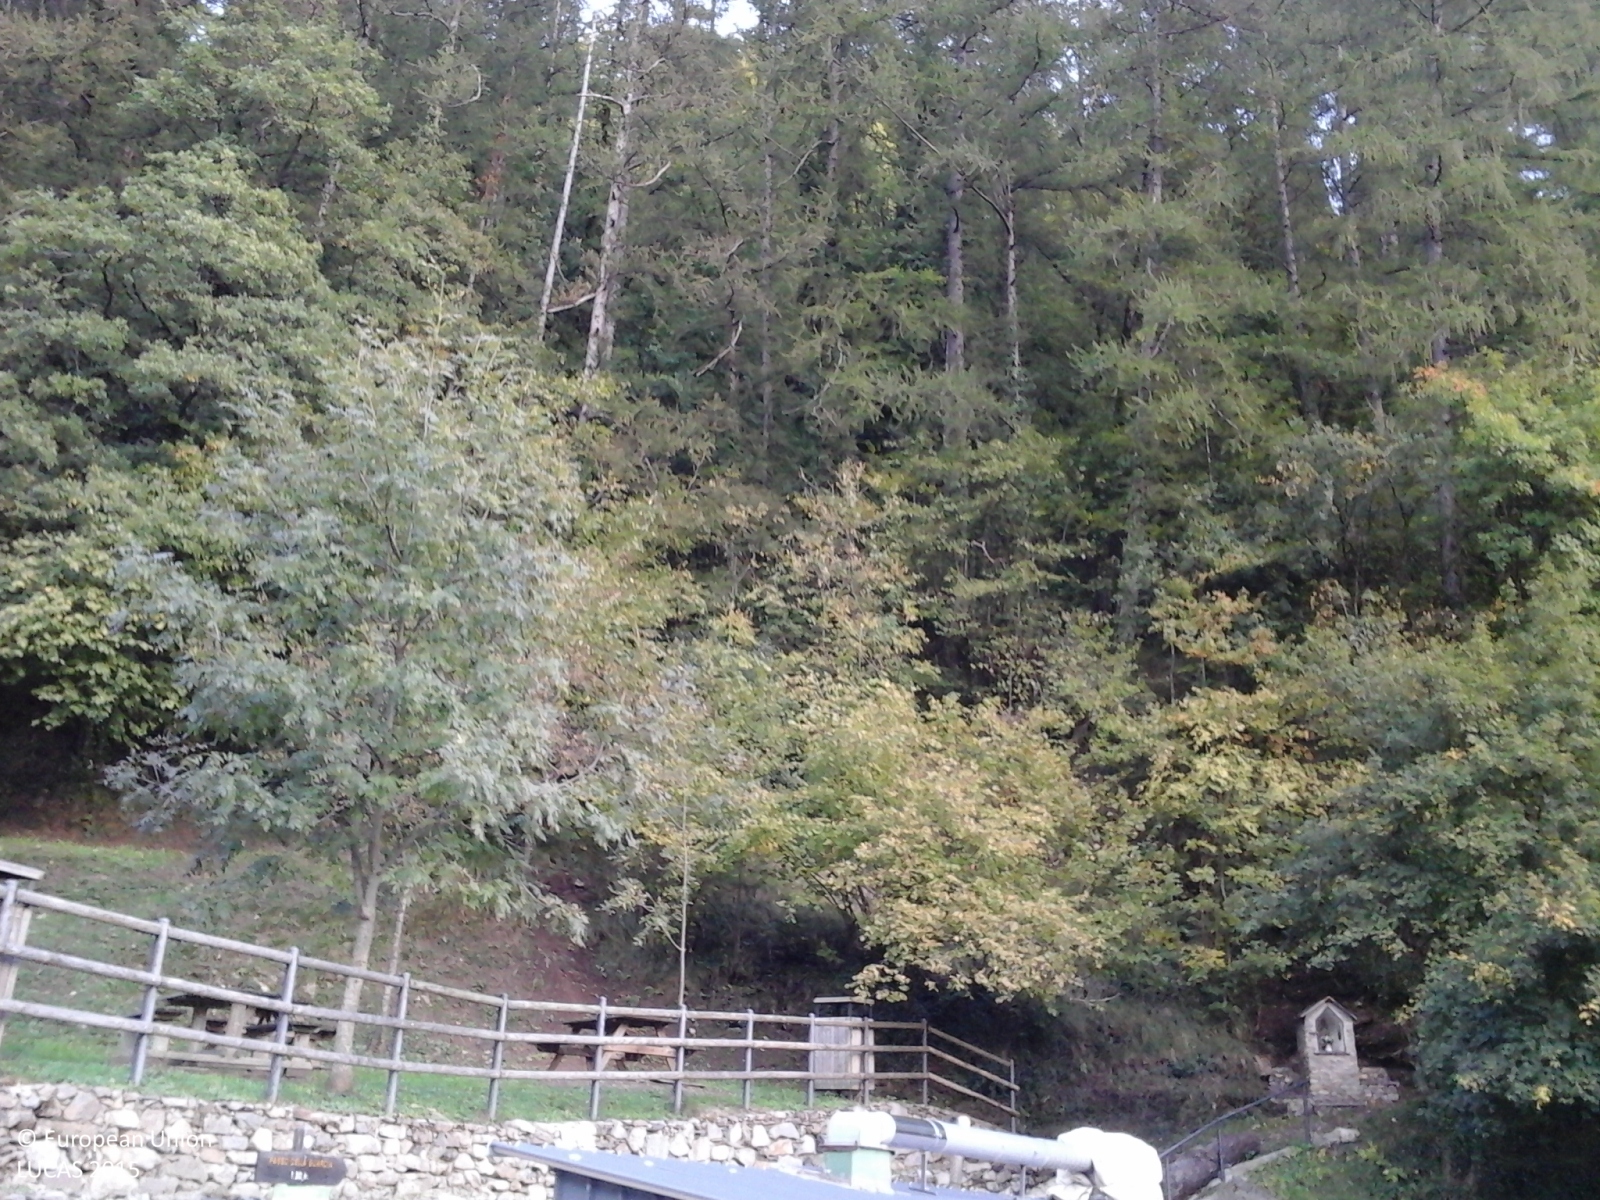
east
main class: Woodland
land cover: Other coniferous woodland
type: alpine coniferous forest
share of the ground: > 75 %
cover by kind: coniferous forest trees 70 %, herbaceous plants 30 %
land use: Semi-natural and natural areas not in use
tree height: > 5 m
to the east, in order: Other coniferous woodland; Shrubland with sparse tree cover; Other coniferous woodland
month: October
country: IT
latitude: 44.0549
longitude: 7.7210
